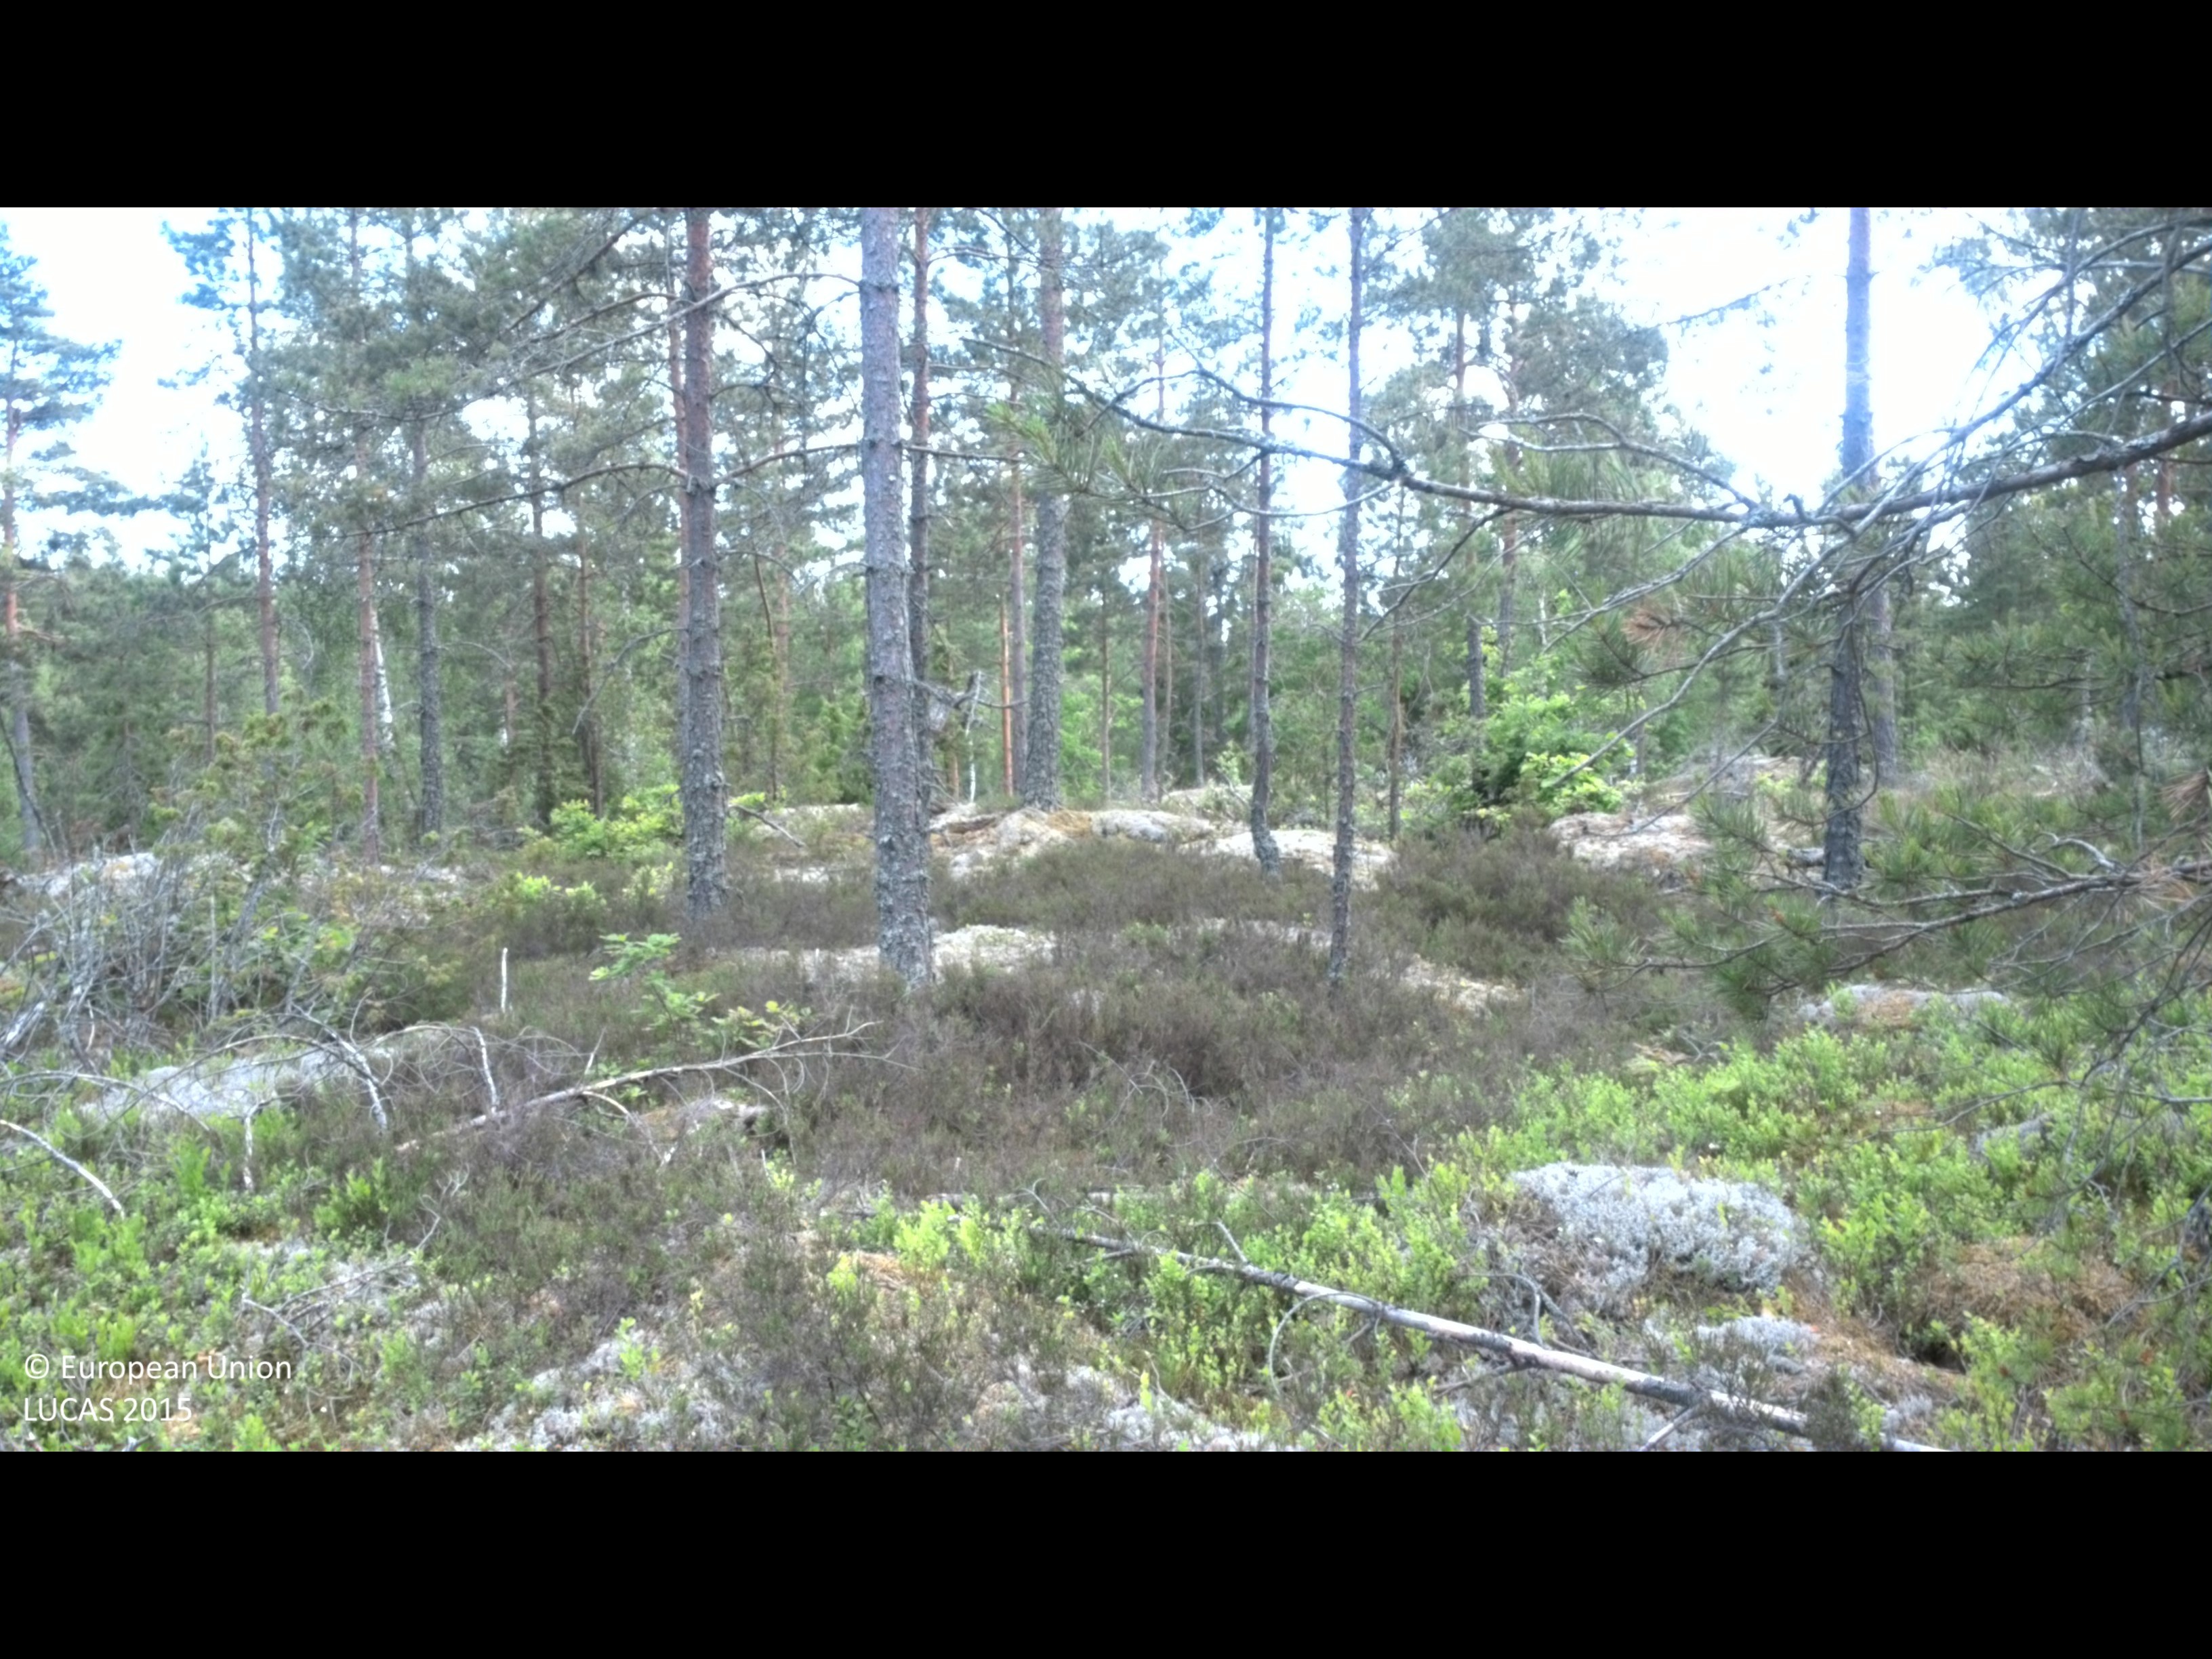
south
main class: Woodland
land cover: Pine dominated coniferous woodland
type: boreal forest
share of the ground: 25 - 50 %
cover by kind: coniferous forest trees 40 %, shrubs 40 %, lichens and mosses 10 %, broadleaved forest trees 5 %, herbaceous plants 5 %
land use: Forestry
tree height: > 5 m
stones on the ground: < 10 %
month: June
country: SE
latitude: 57.6788
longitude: 16.5893
